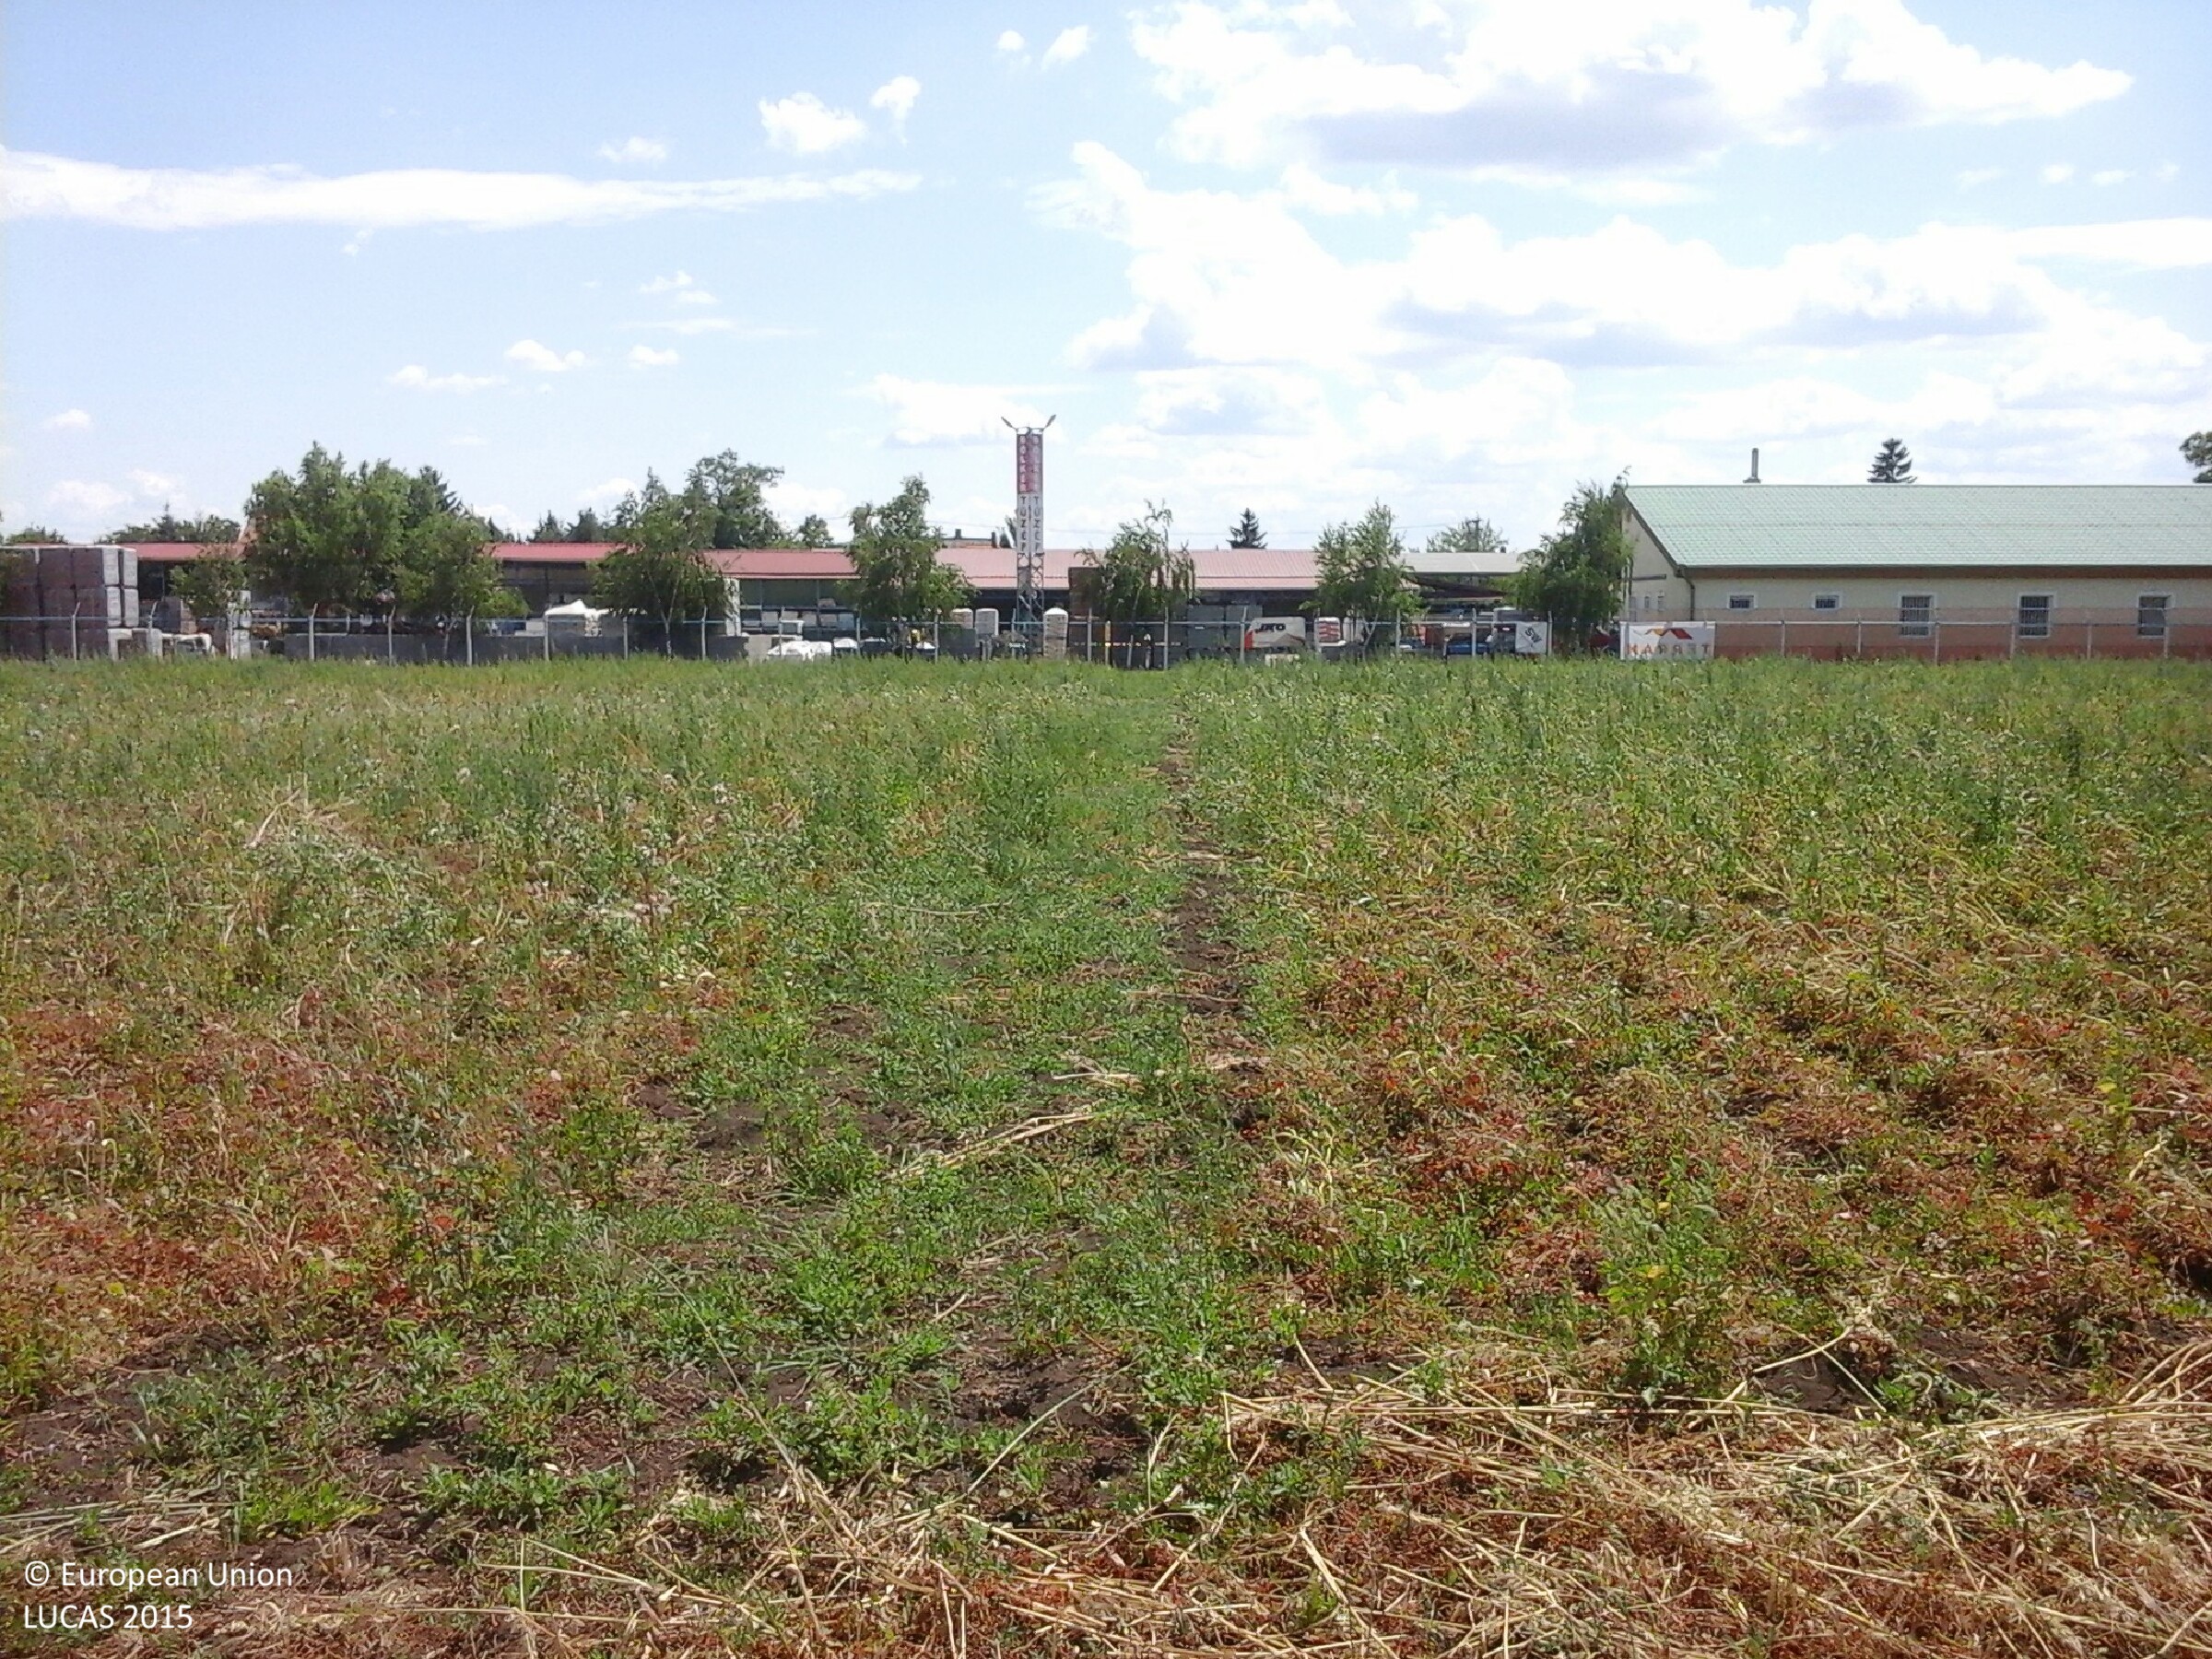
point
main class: Cropland
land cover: Dry pulses
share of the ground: > 75 %
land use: Agriculture (excluding fallow land and kitchen gardens)
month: July
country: HU
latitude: 47.8226
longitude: 20.5719
